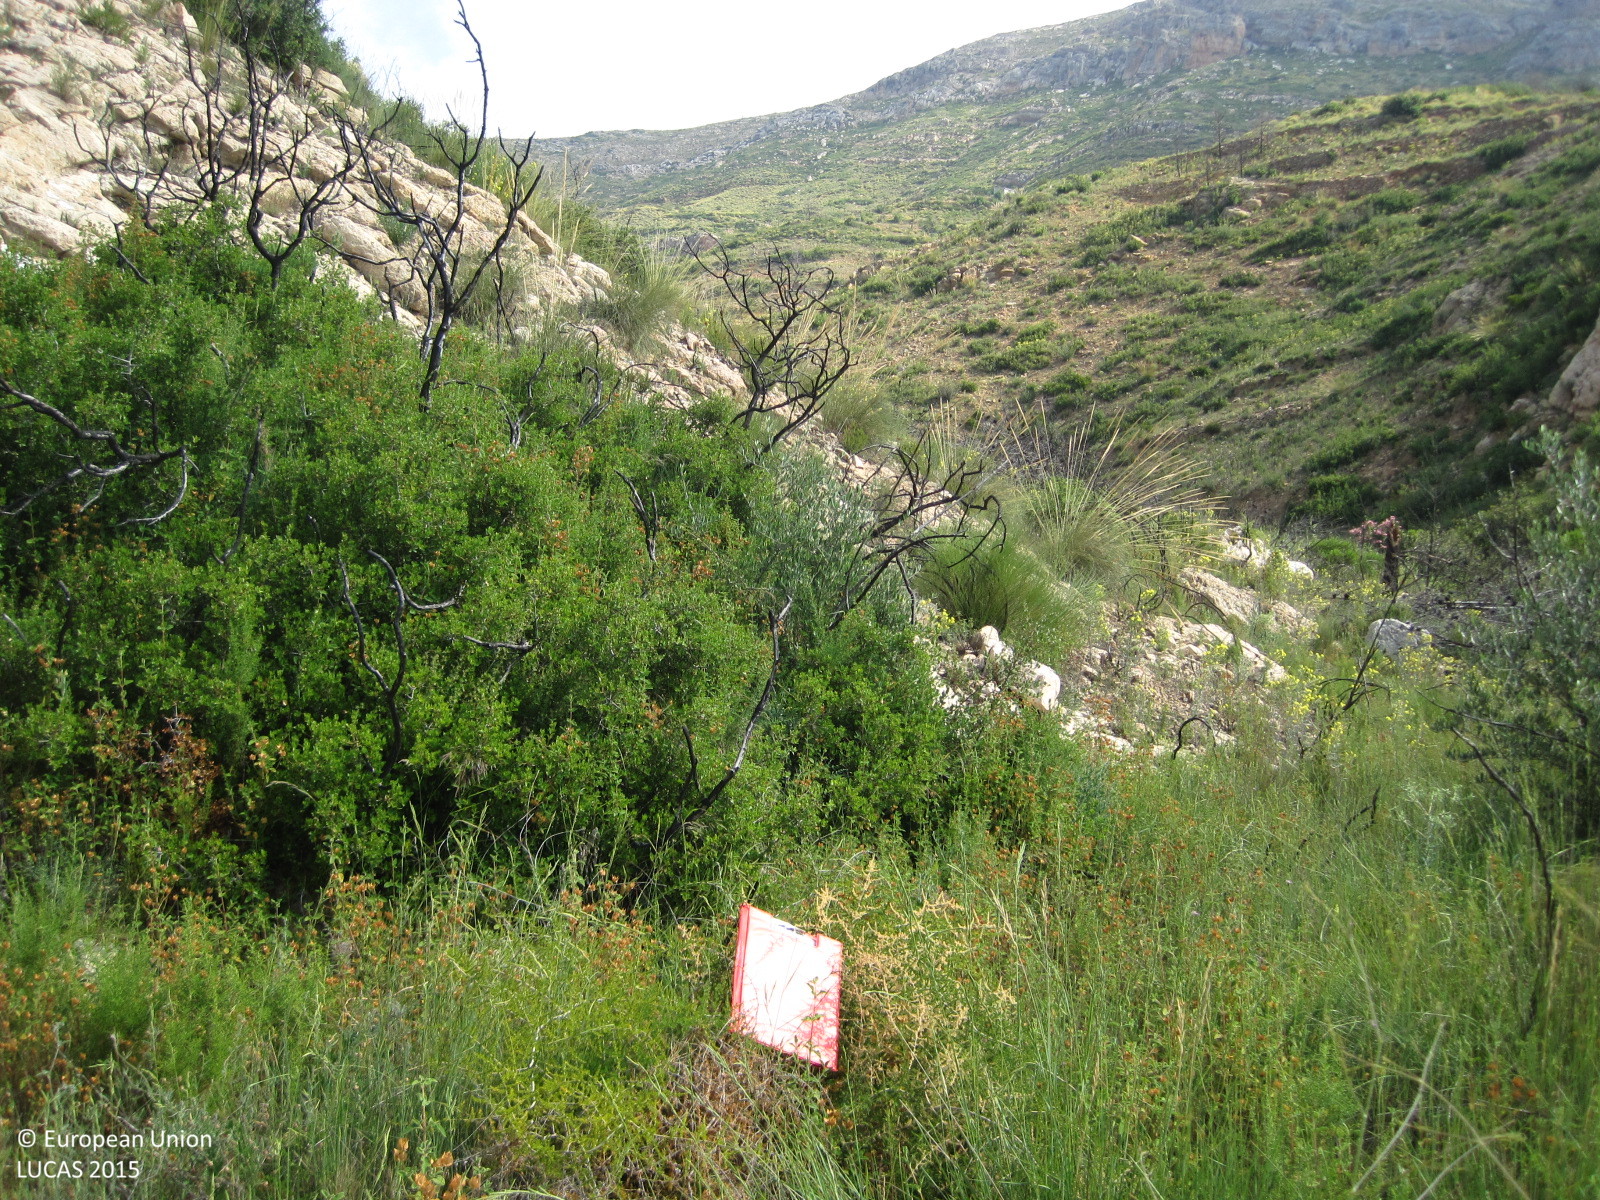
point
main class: Grassland
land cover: Grassland with sparse tree/shrub cover
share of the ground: > 75 %
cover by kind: herbaceous plants 85 %, shrubs 10 %, broadleaved forest trees 5 %
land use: Semi-natural and natural areas not in use
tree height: < 5 m
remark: Burnt area
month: June
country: ES
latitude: 39.3000
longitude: -0.8398
